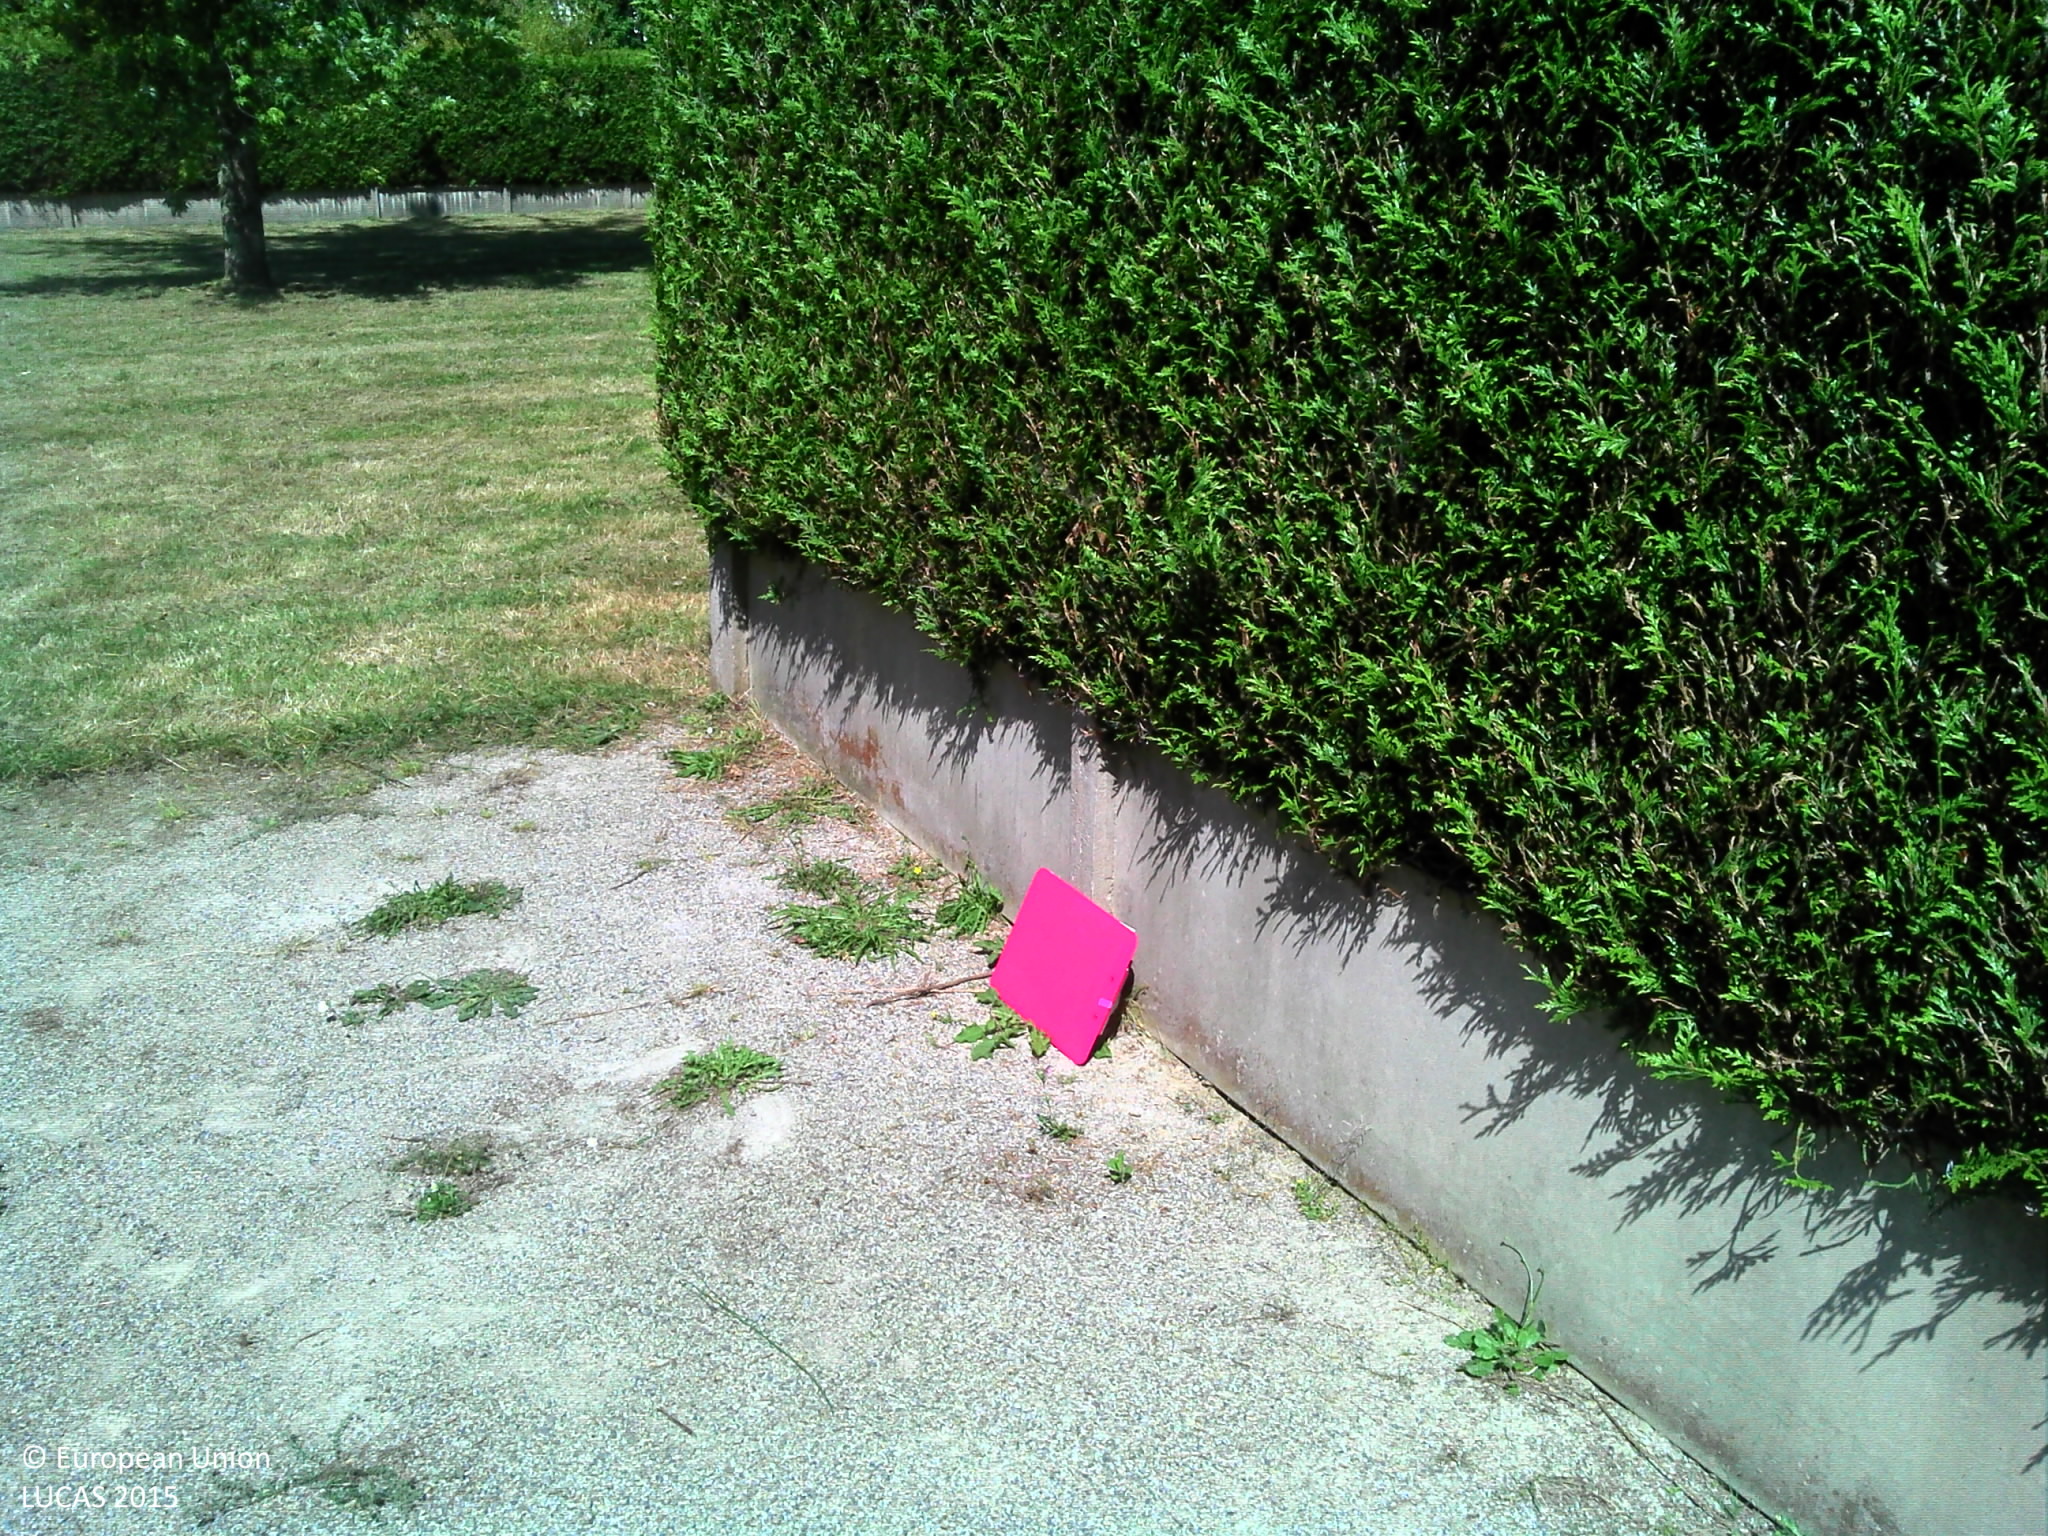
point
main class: Grassland
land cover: Grassland with sparse tree/shrub cover
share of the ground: > 75 %
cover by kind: herbaceous plants 95 %, broadleaved forest trees 5 %
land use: Amenities, museums, leisure
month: June
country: FR
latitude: 48.0015
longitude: -1.6678
